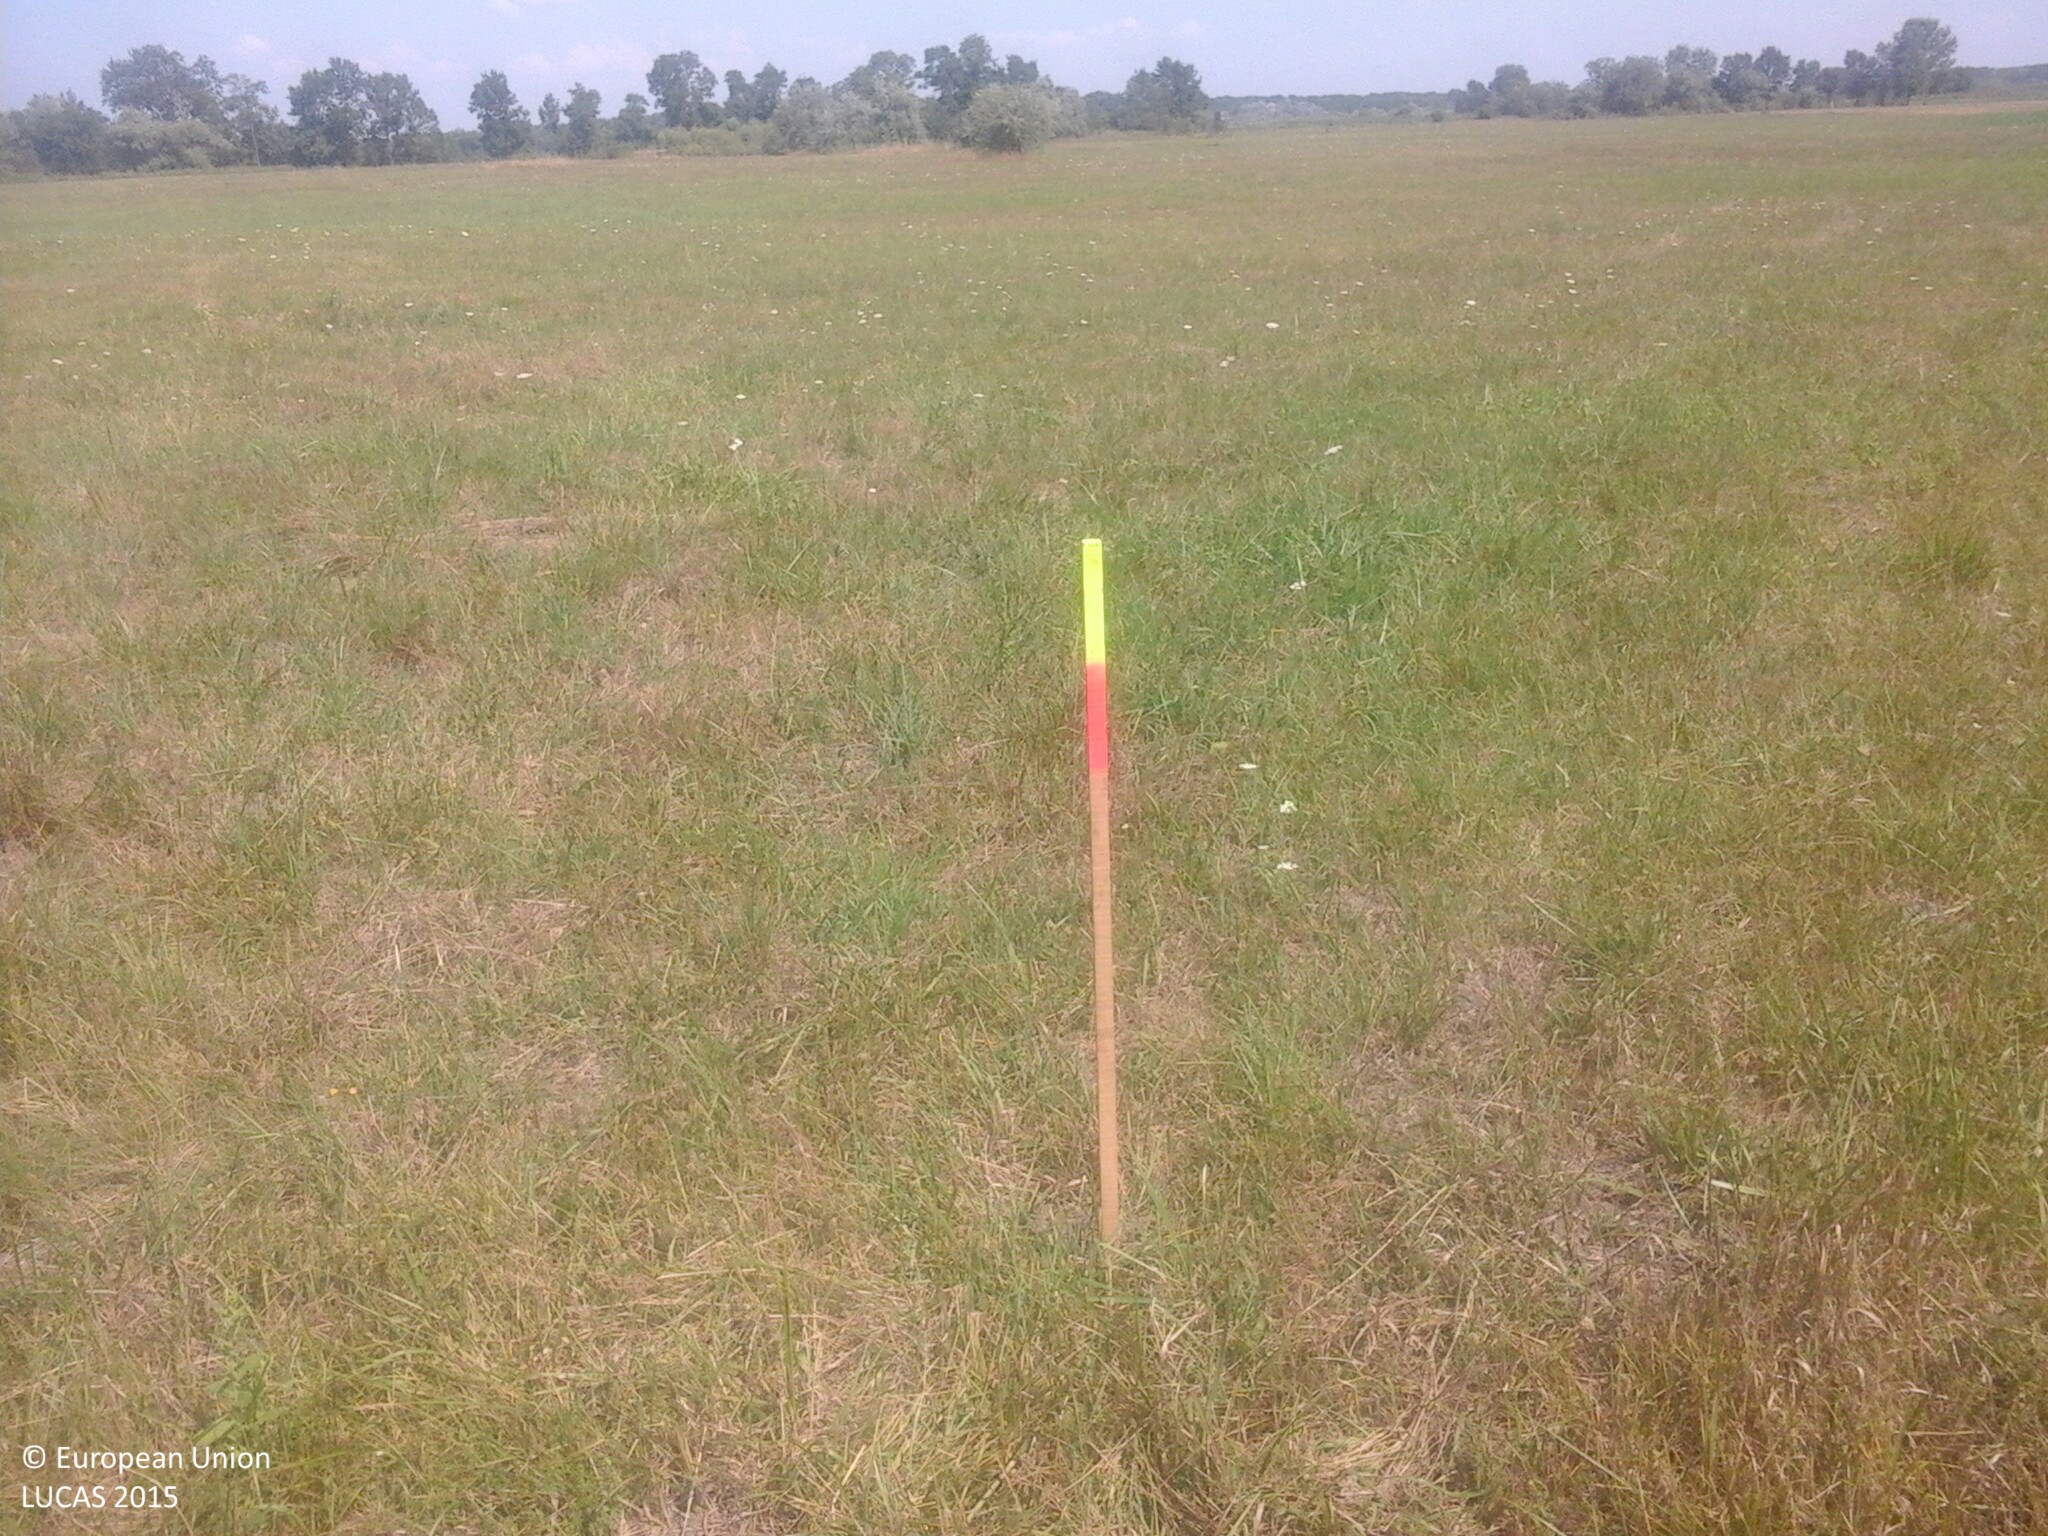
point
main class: Grassland
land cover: Grassland without tree/shrub cover
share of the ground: > 75 %
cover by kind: herbaceous plants 100 %
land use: Agriculture (excluding fallow land and kitchen gardens)
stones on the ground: < 10 %
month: August
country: HU
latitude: 46.9527
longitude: 18.5134
